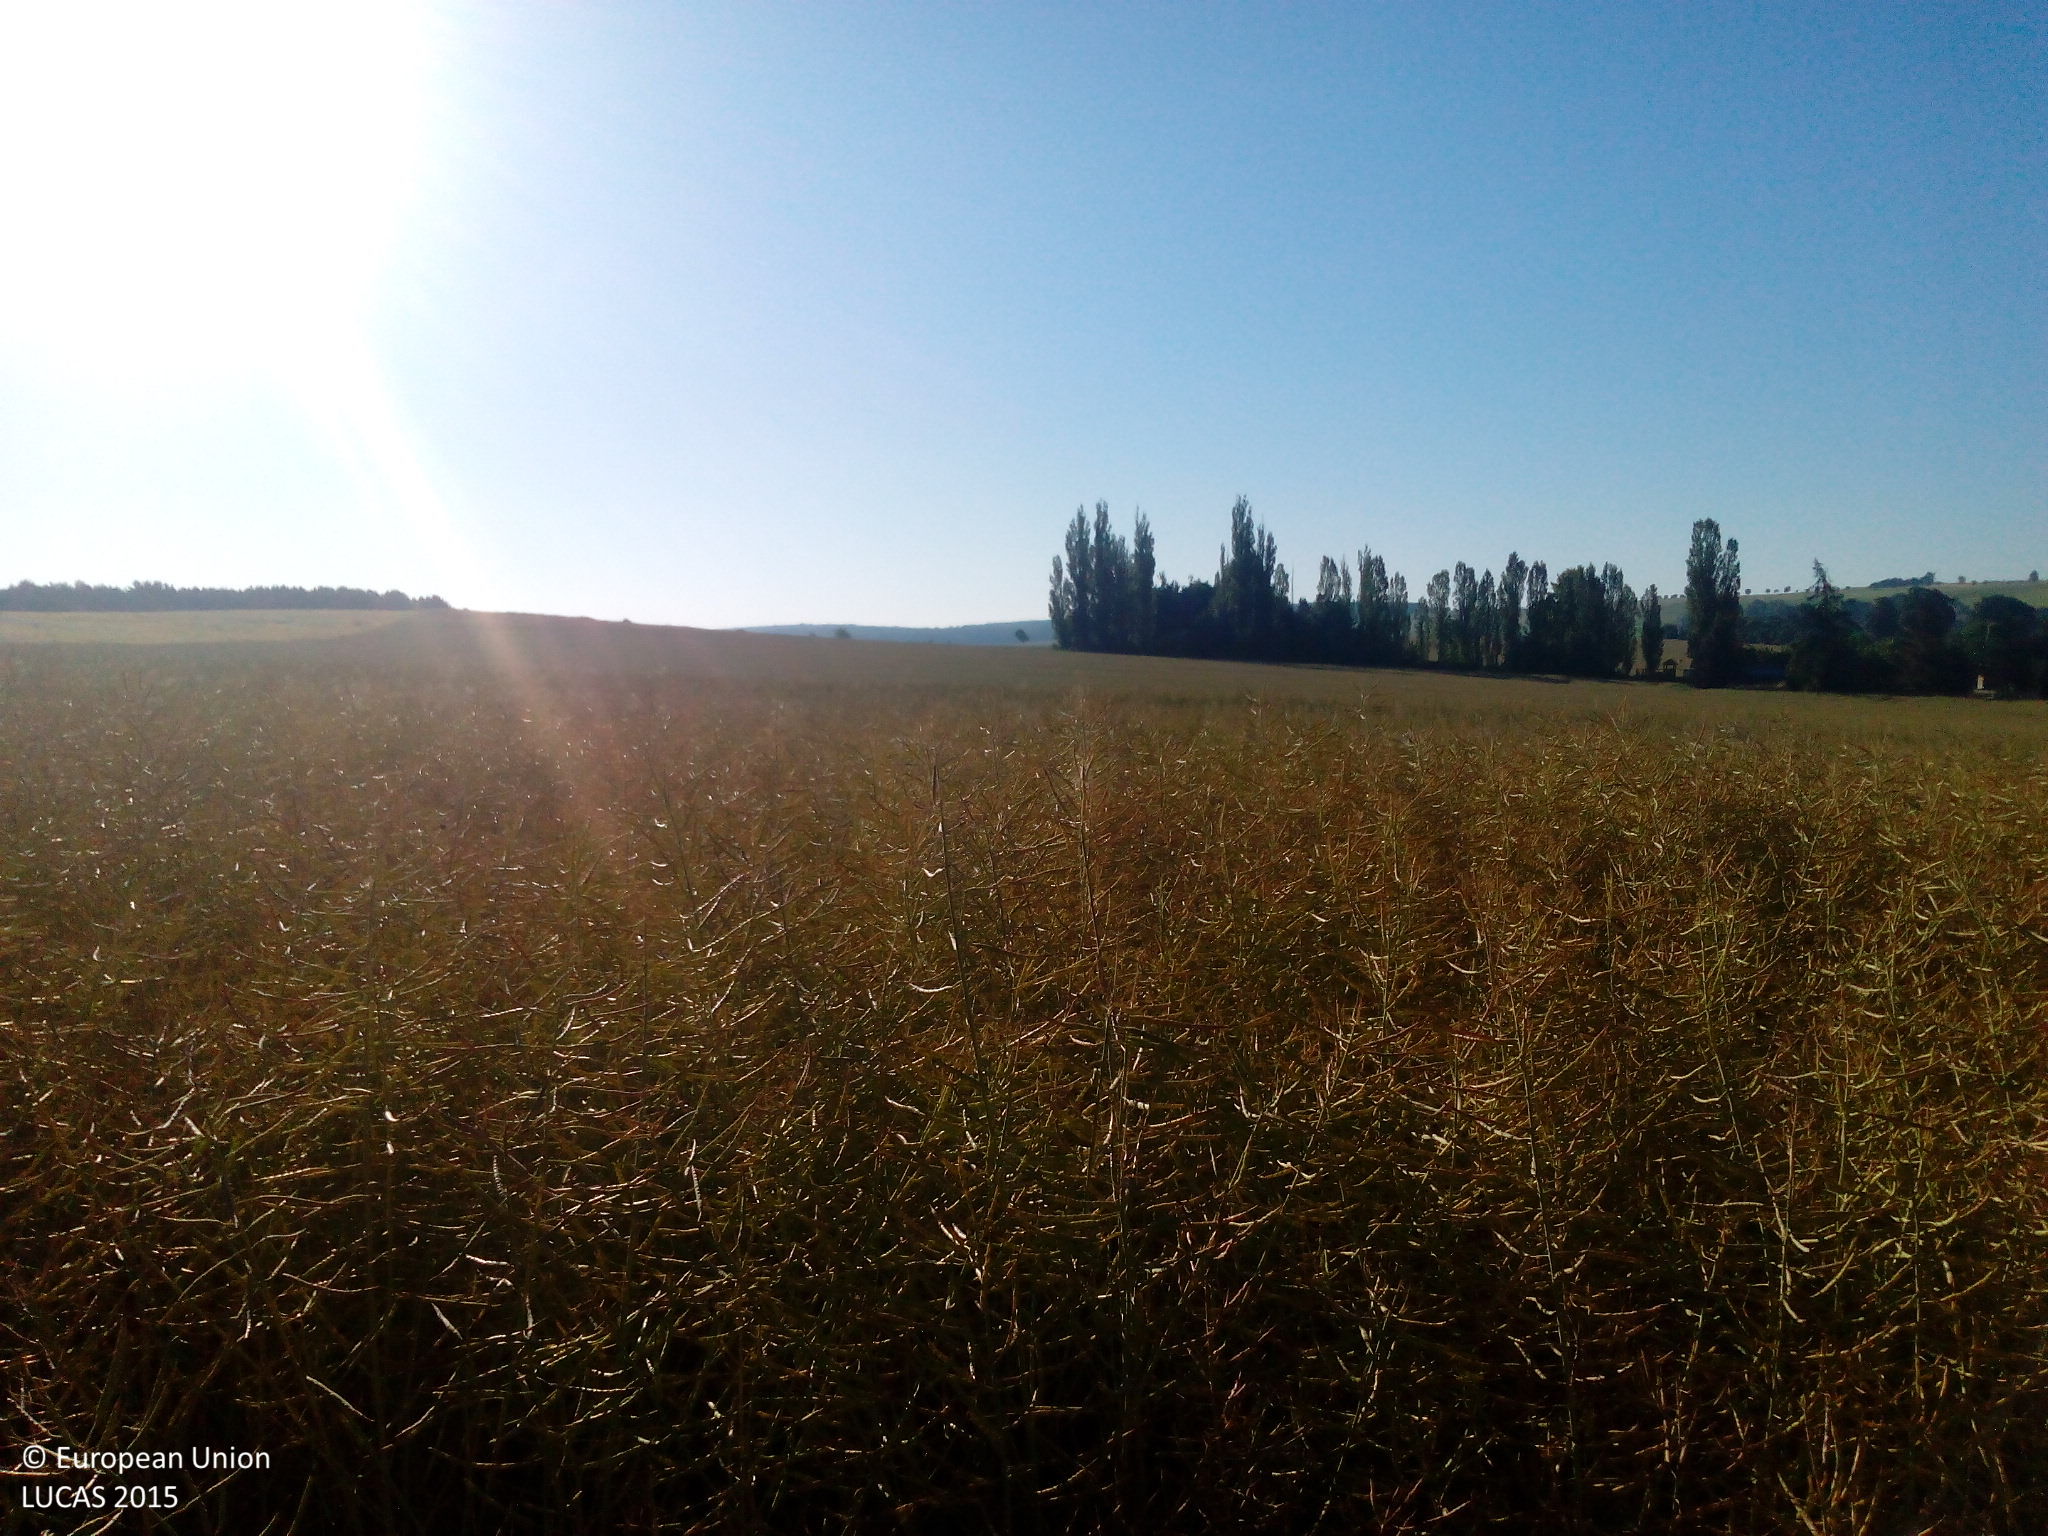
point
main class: Cropland
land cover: Rape and turnip rape
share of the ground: > 75 %
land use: Agriculture (excluding fallow land and kitchen gardens)
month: July
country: DE
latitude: 51.3652
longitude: 13.1169
